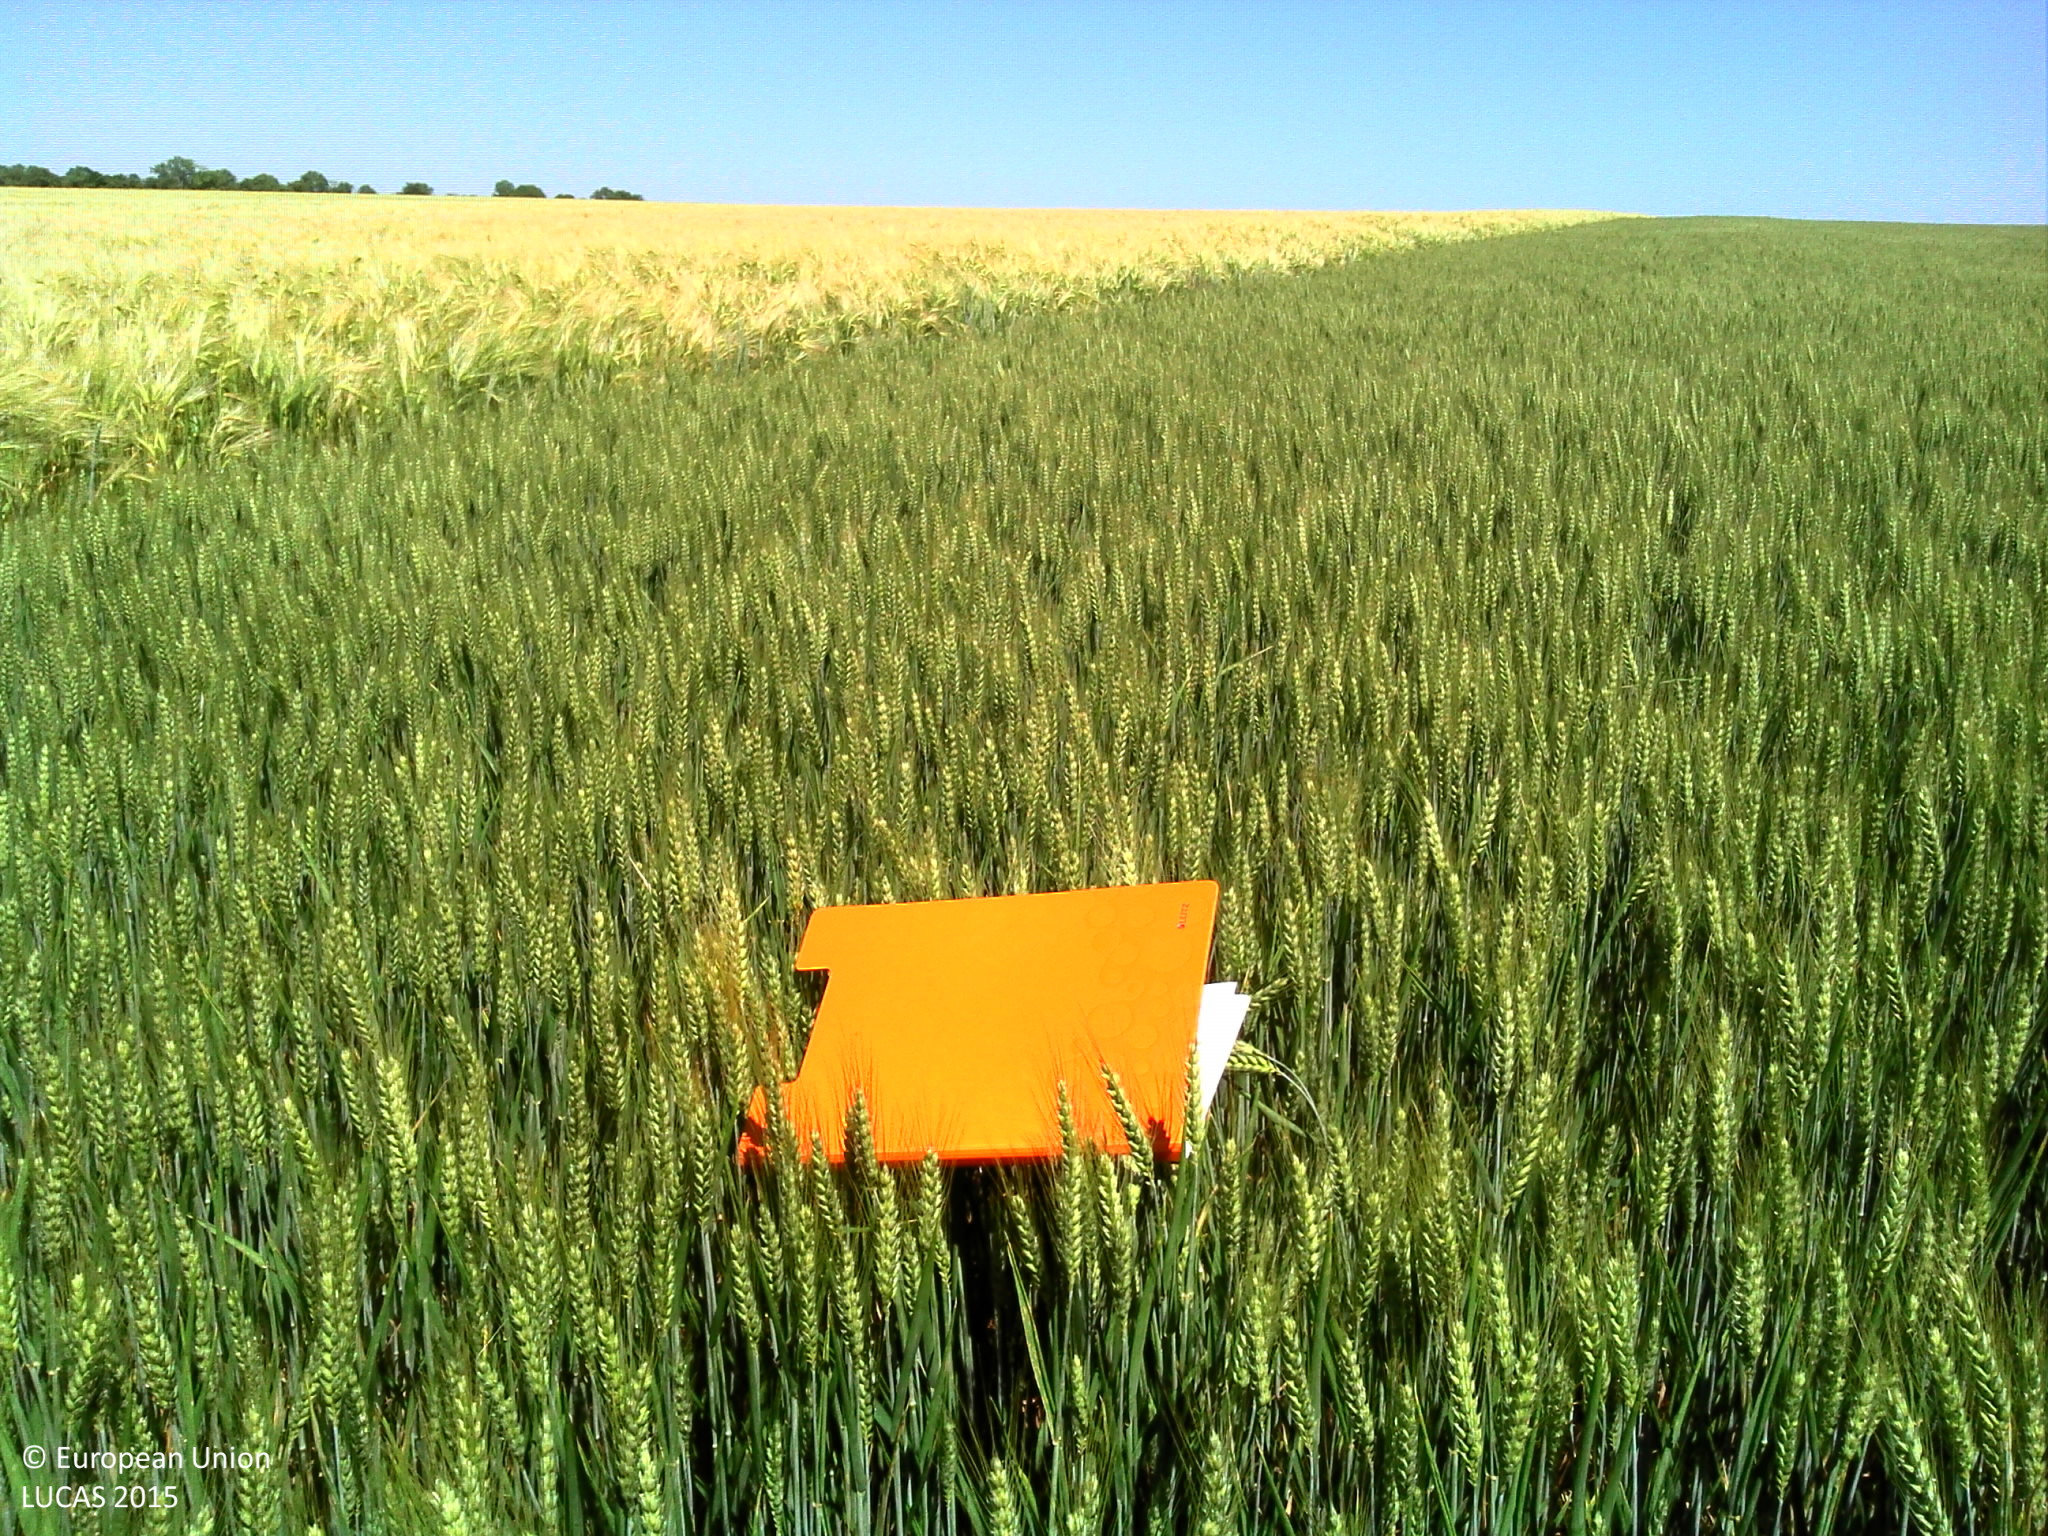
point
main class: Cropland
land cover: Common wheat
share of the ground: > 75 %
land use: Agriculture (excluding fallow land and kitchen gardens)
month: June
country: FR
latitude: 47.0249
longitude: 2.7184
